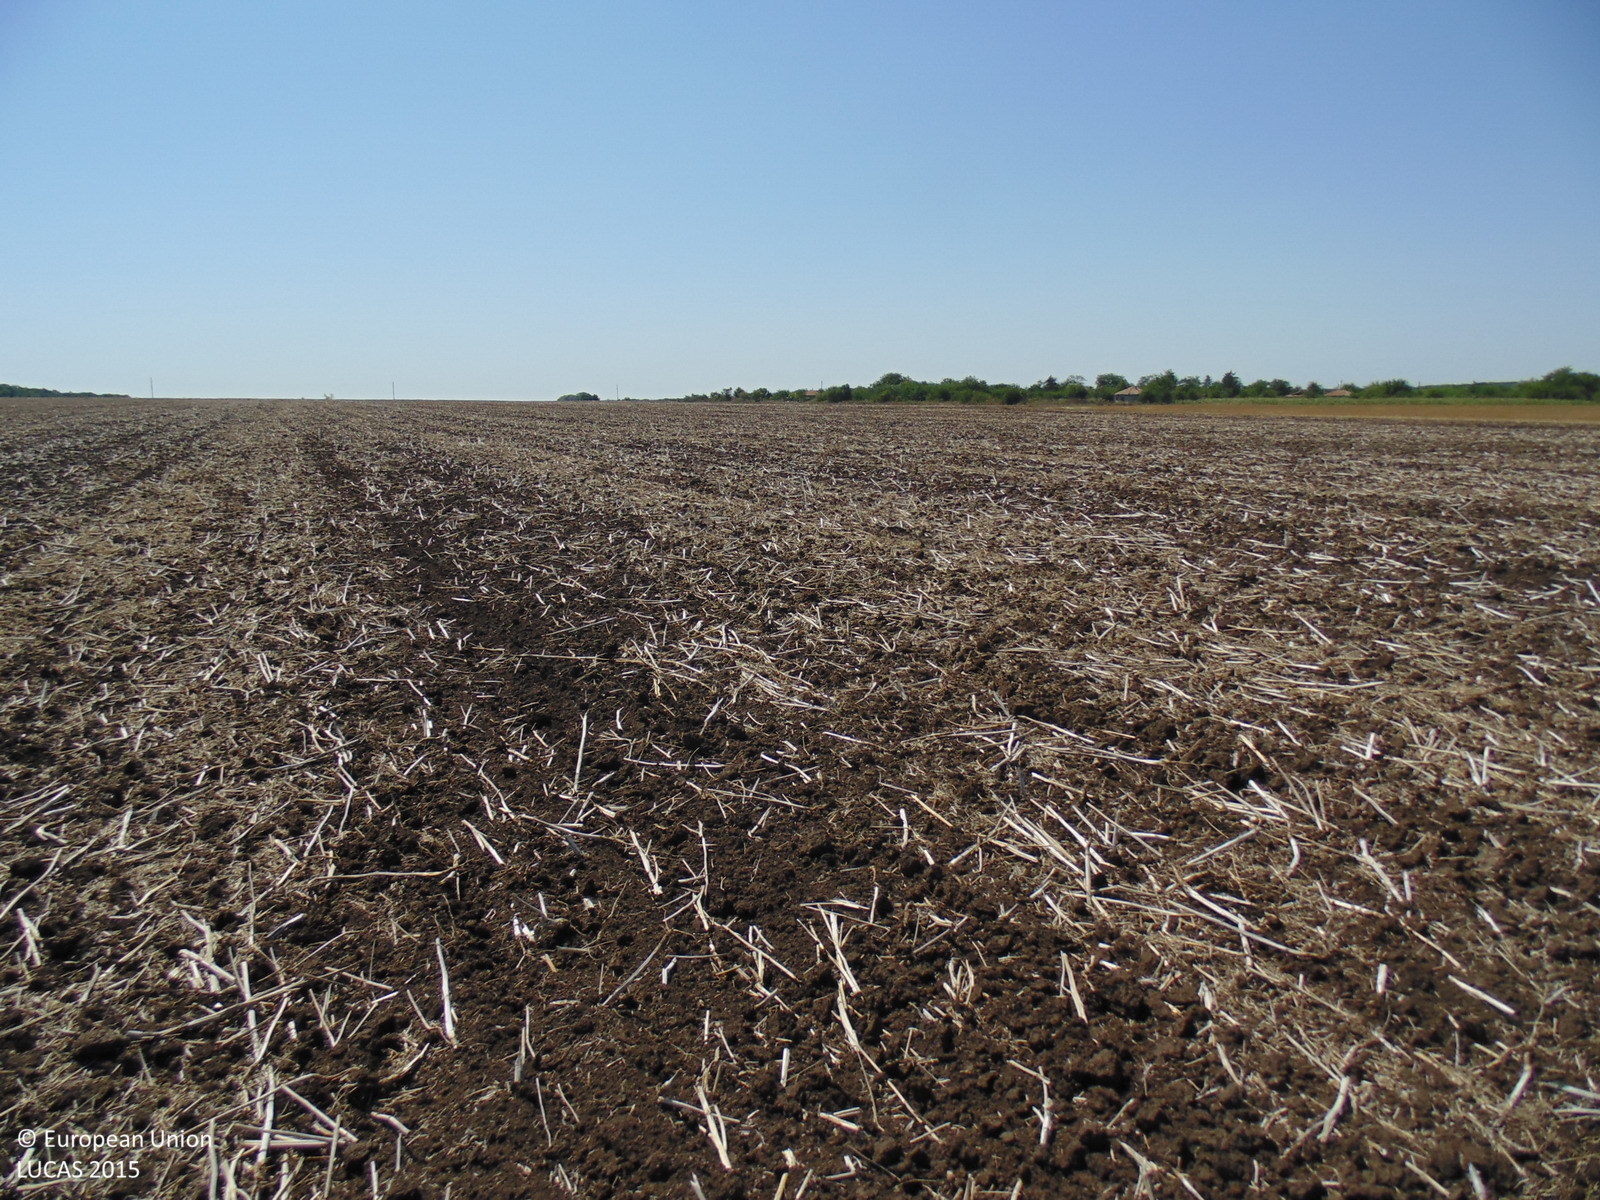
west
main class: Cropland
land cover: Rape and turnip rape
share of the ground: < 10 %
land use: Agriculture (excluding fallow land and kitchen gardens)
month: August
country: BG
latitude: 43.5350
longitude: 28.2069
